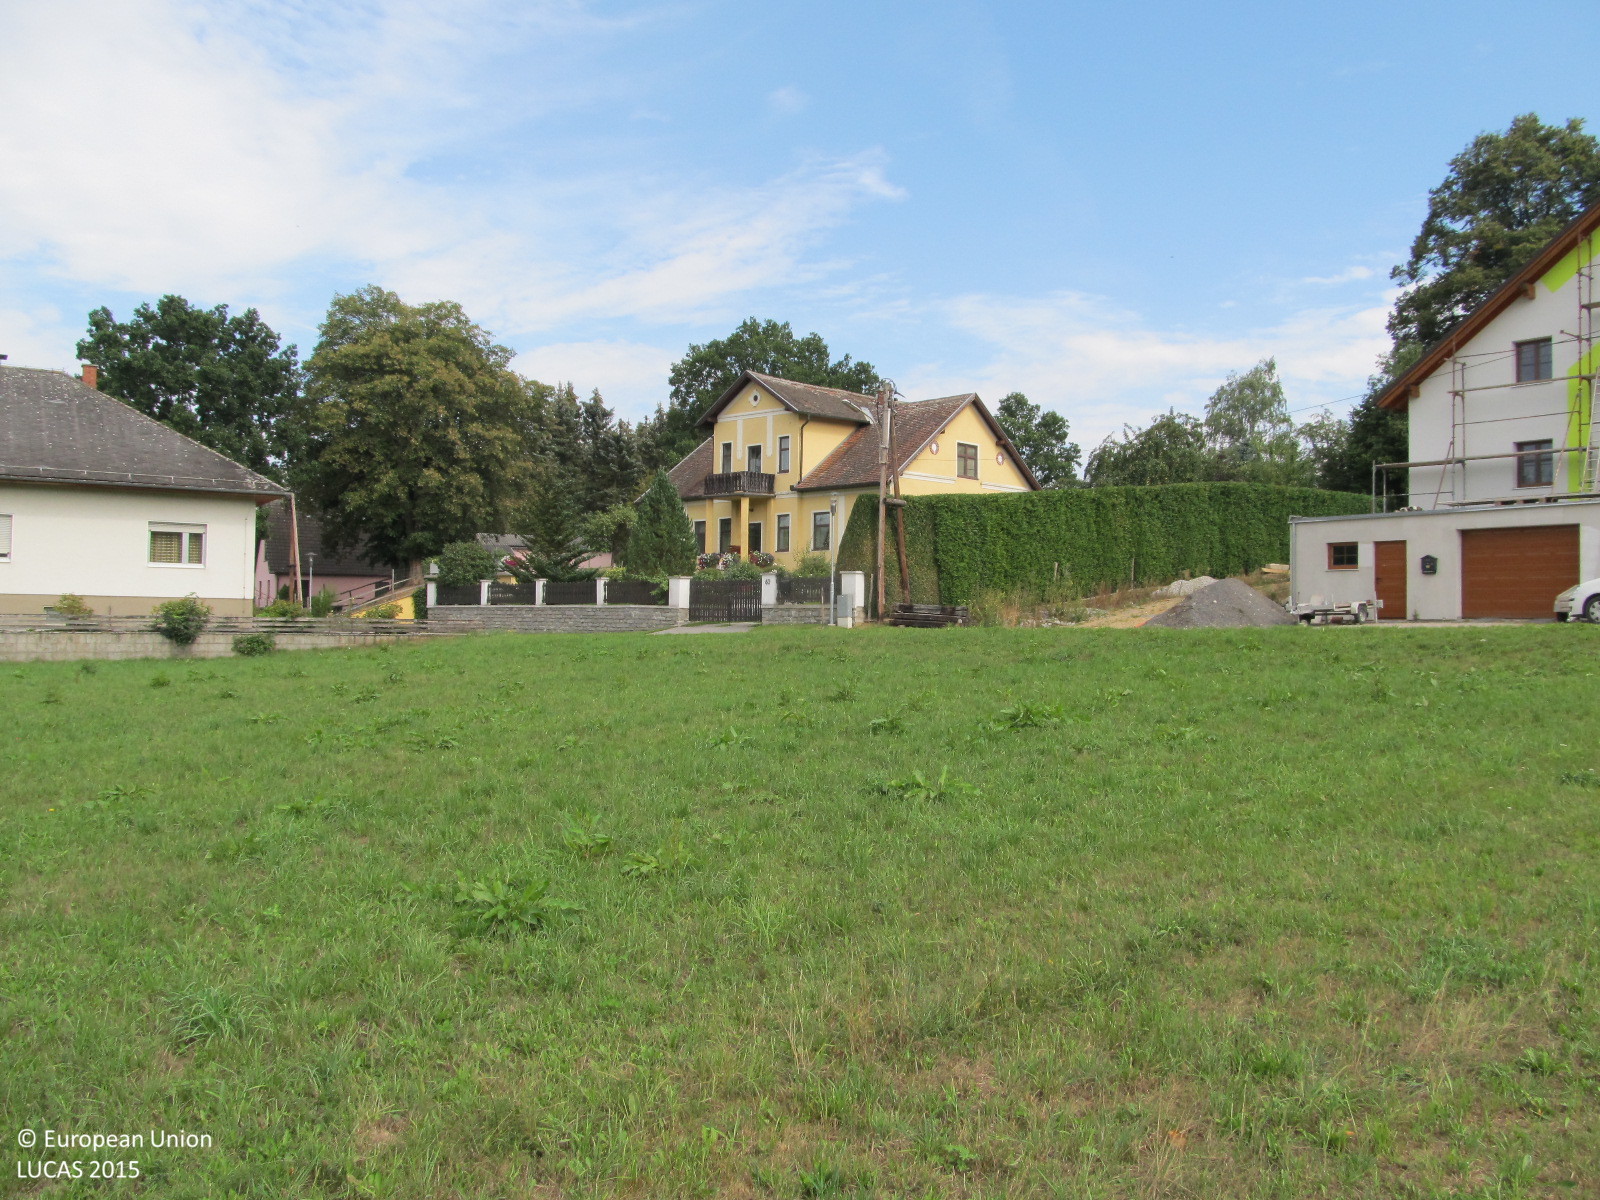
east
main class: Grassland
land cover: Grassland without tree/shrub cover
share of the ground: > 75 %
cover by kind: herbaceous plants 100 %
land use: Agriculture (excluding fallow land and kitchen gardens)
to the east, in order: Grassland without tree/shrub cover; Artificial constructions in urban areas; Spruce dominated mixed woodland; Temporary grasslands; Grass margins; Other bare soil
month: August
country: AT
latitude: 48.9170
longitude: 15.4753
